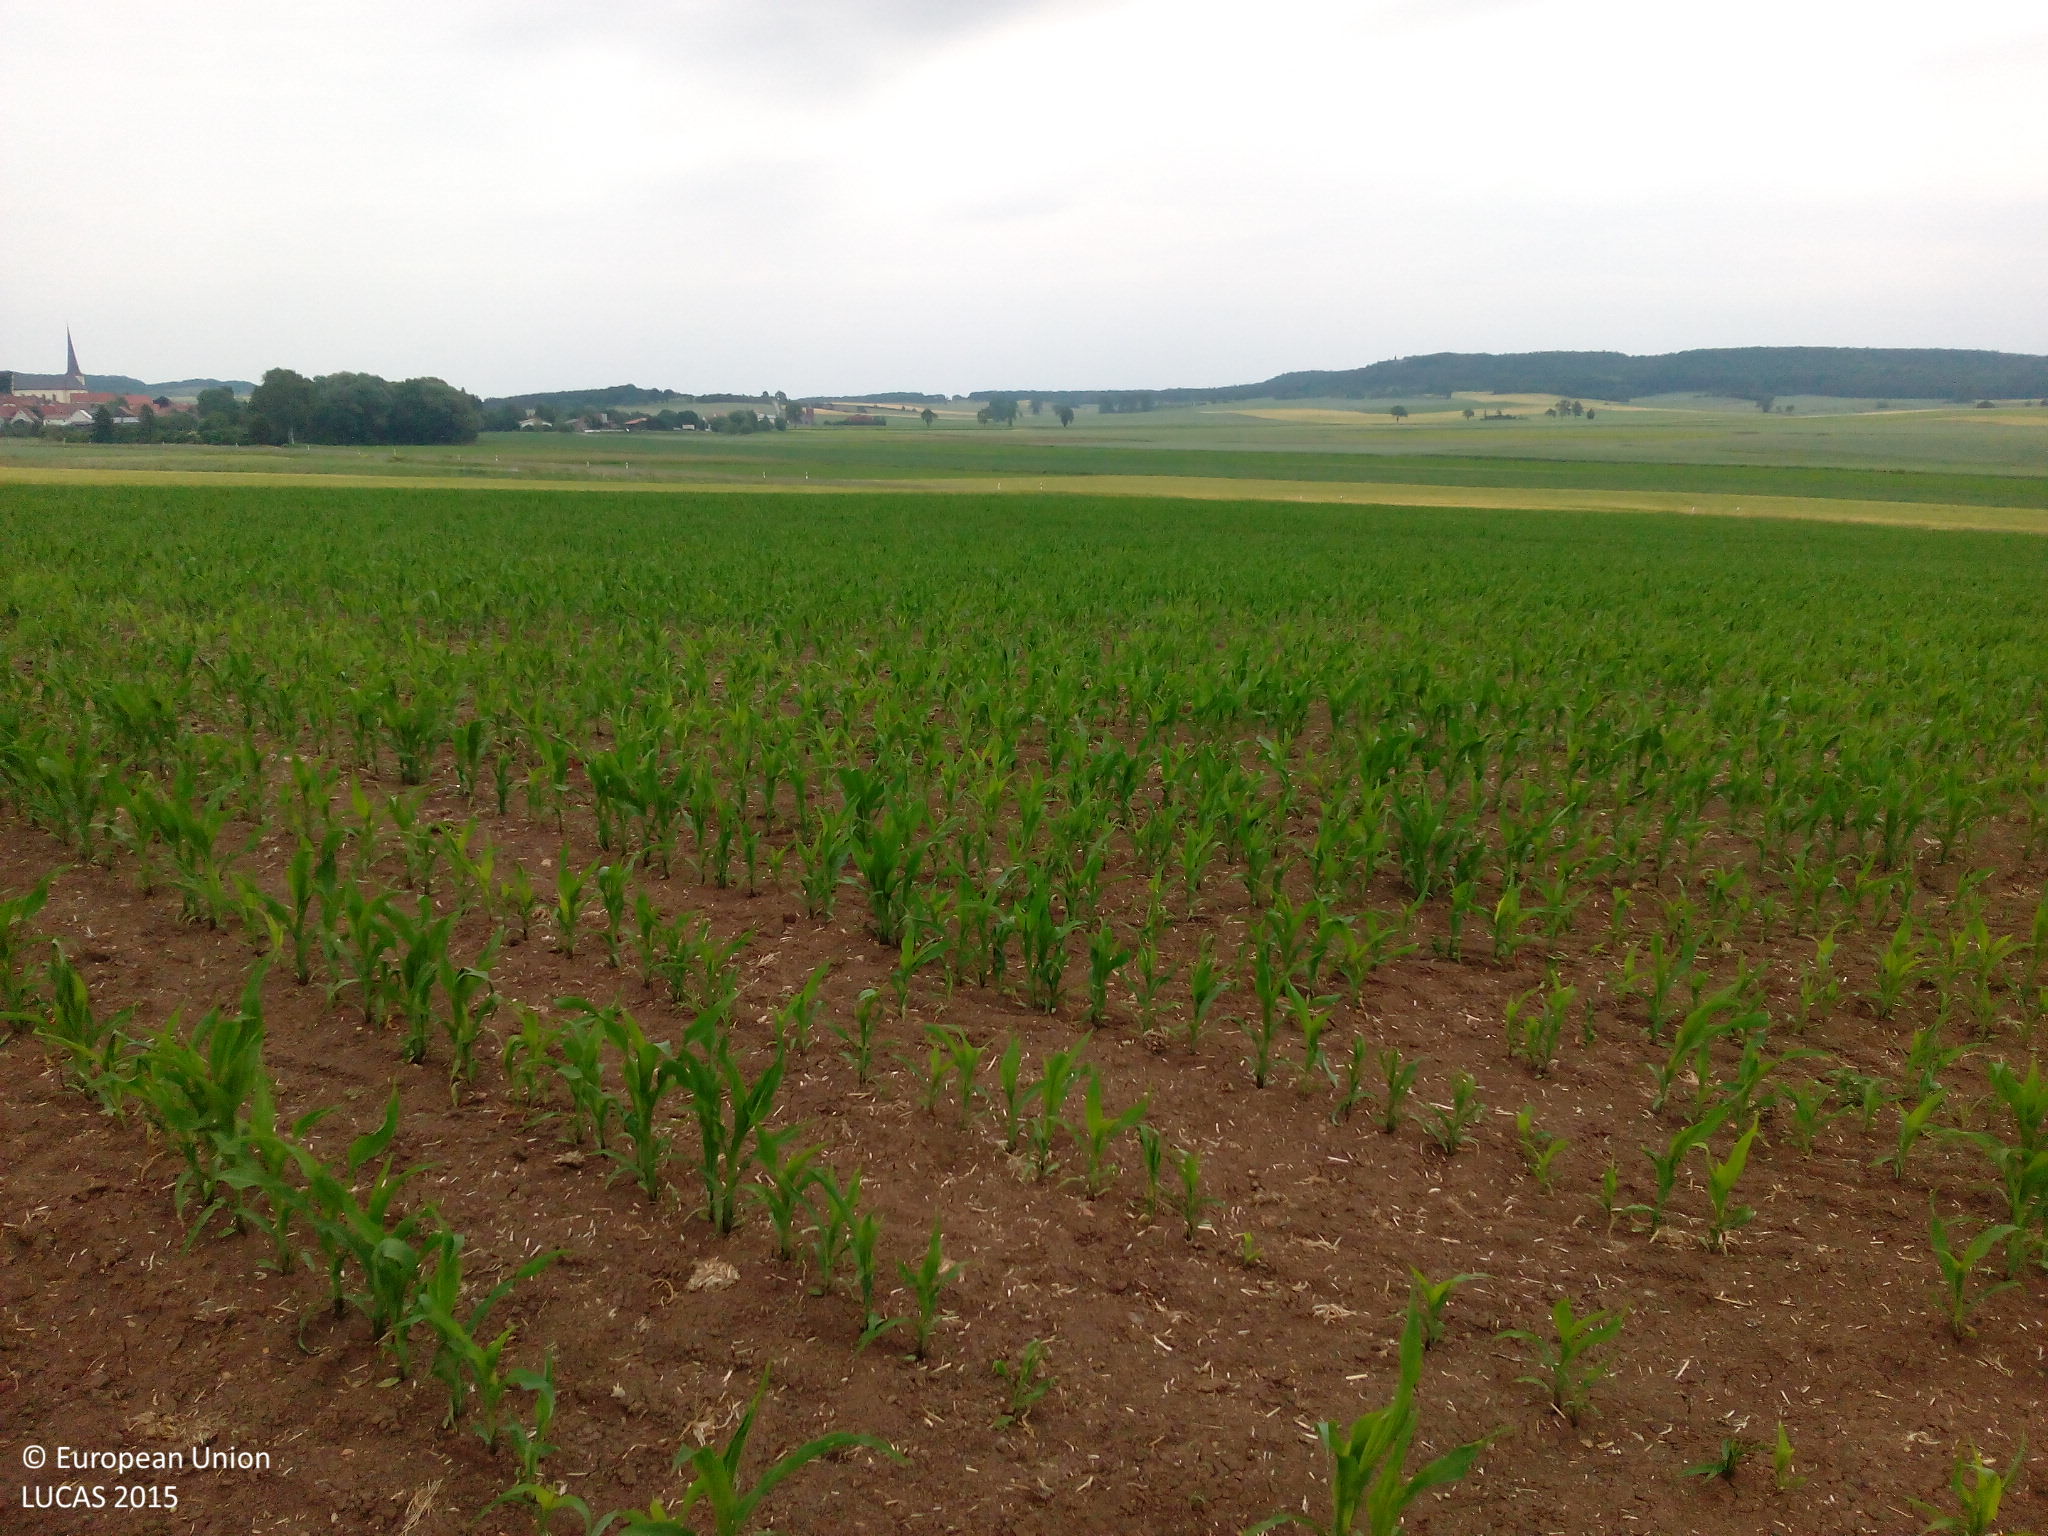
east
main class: Cropland
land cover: Maize
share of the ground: 25 - 50 %
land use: Agriculture (excluding fallow land and kitchen gardens)
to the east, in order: Maize; Barley; Grassland without tree/shrub cover; Ditches and canals; Grass margins; Paved roads, cycling and walking lanes; Grass margins; Ditches and canals; Grassland without tree/shrub cover; Barley
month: June
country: DE
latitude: 50.2908
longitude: 10.5472
